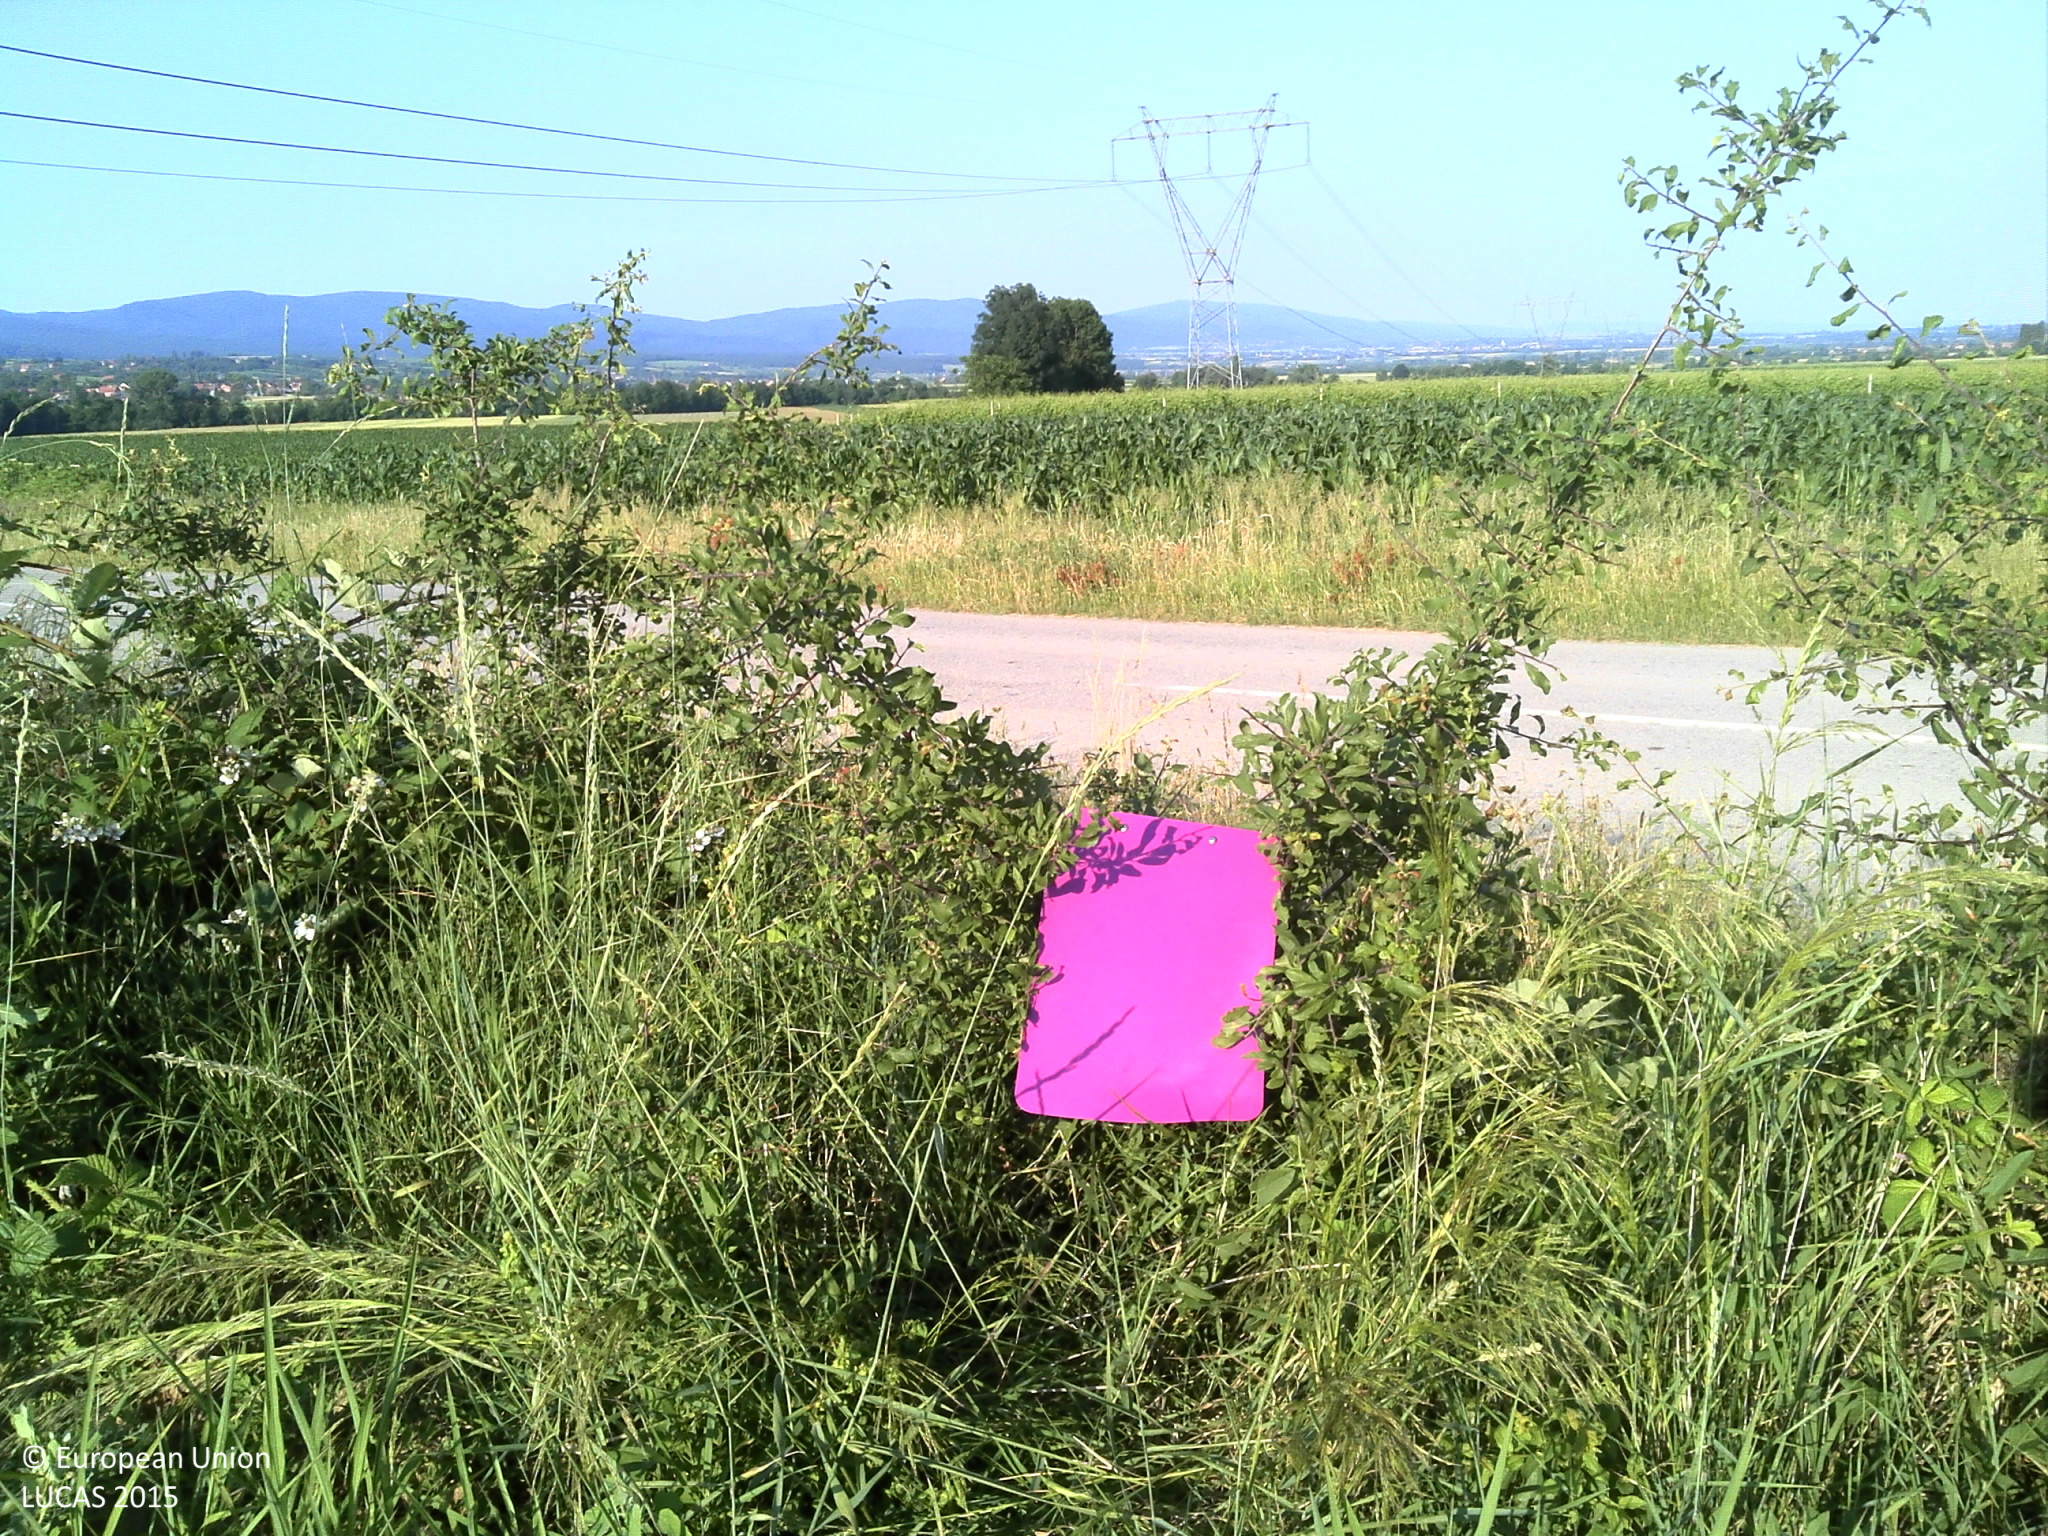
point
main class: Grassland
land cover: Spontaneously vegetated surfaces
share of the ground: > 75 %
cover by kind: herbaceous plants 100 %
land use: Agriculture (excluding fallow land and kitchen gardens)
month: June
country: HR
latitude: 45.4288
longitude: 17.6067
